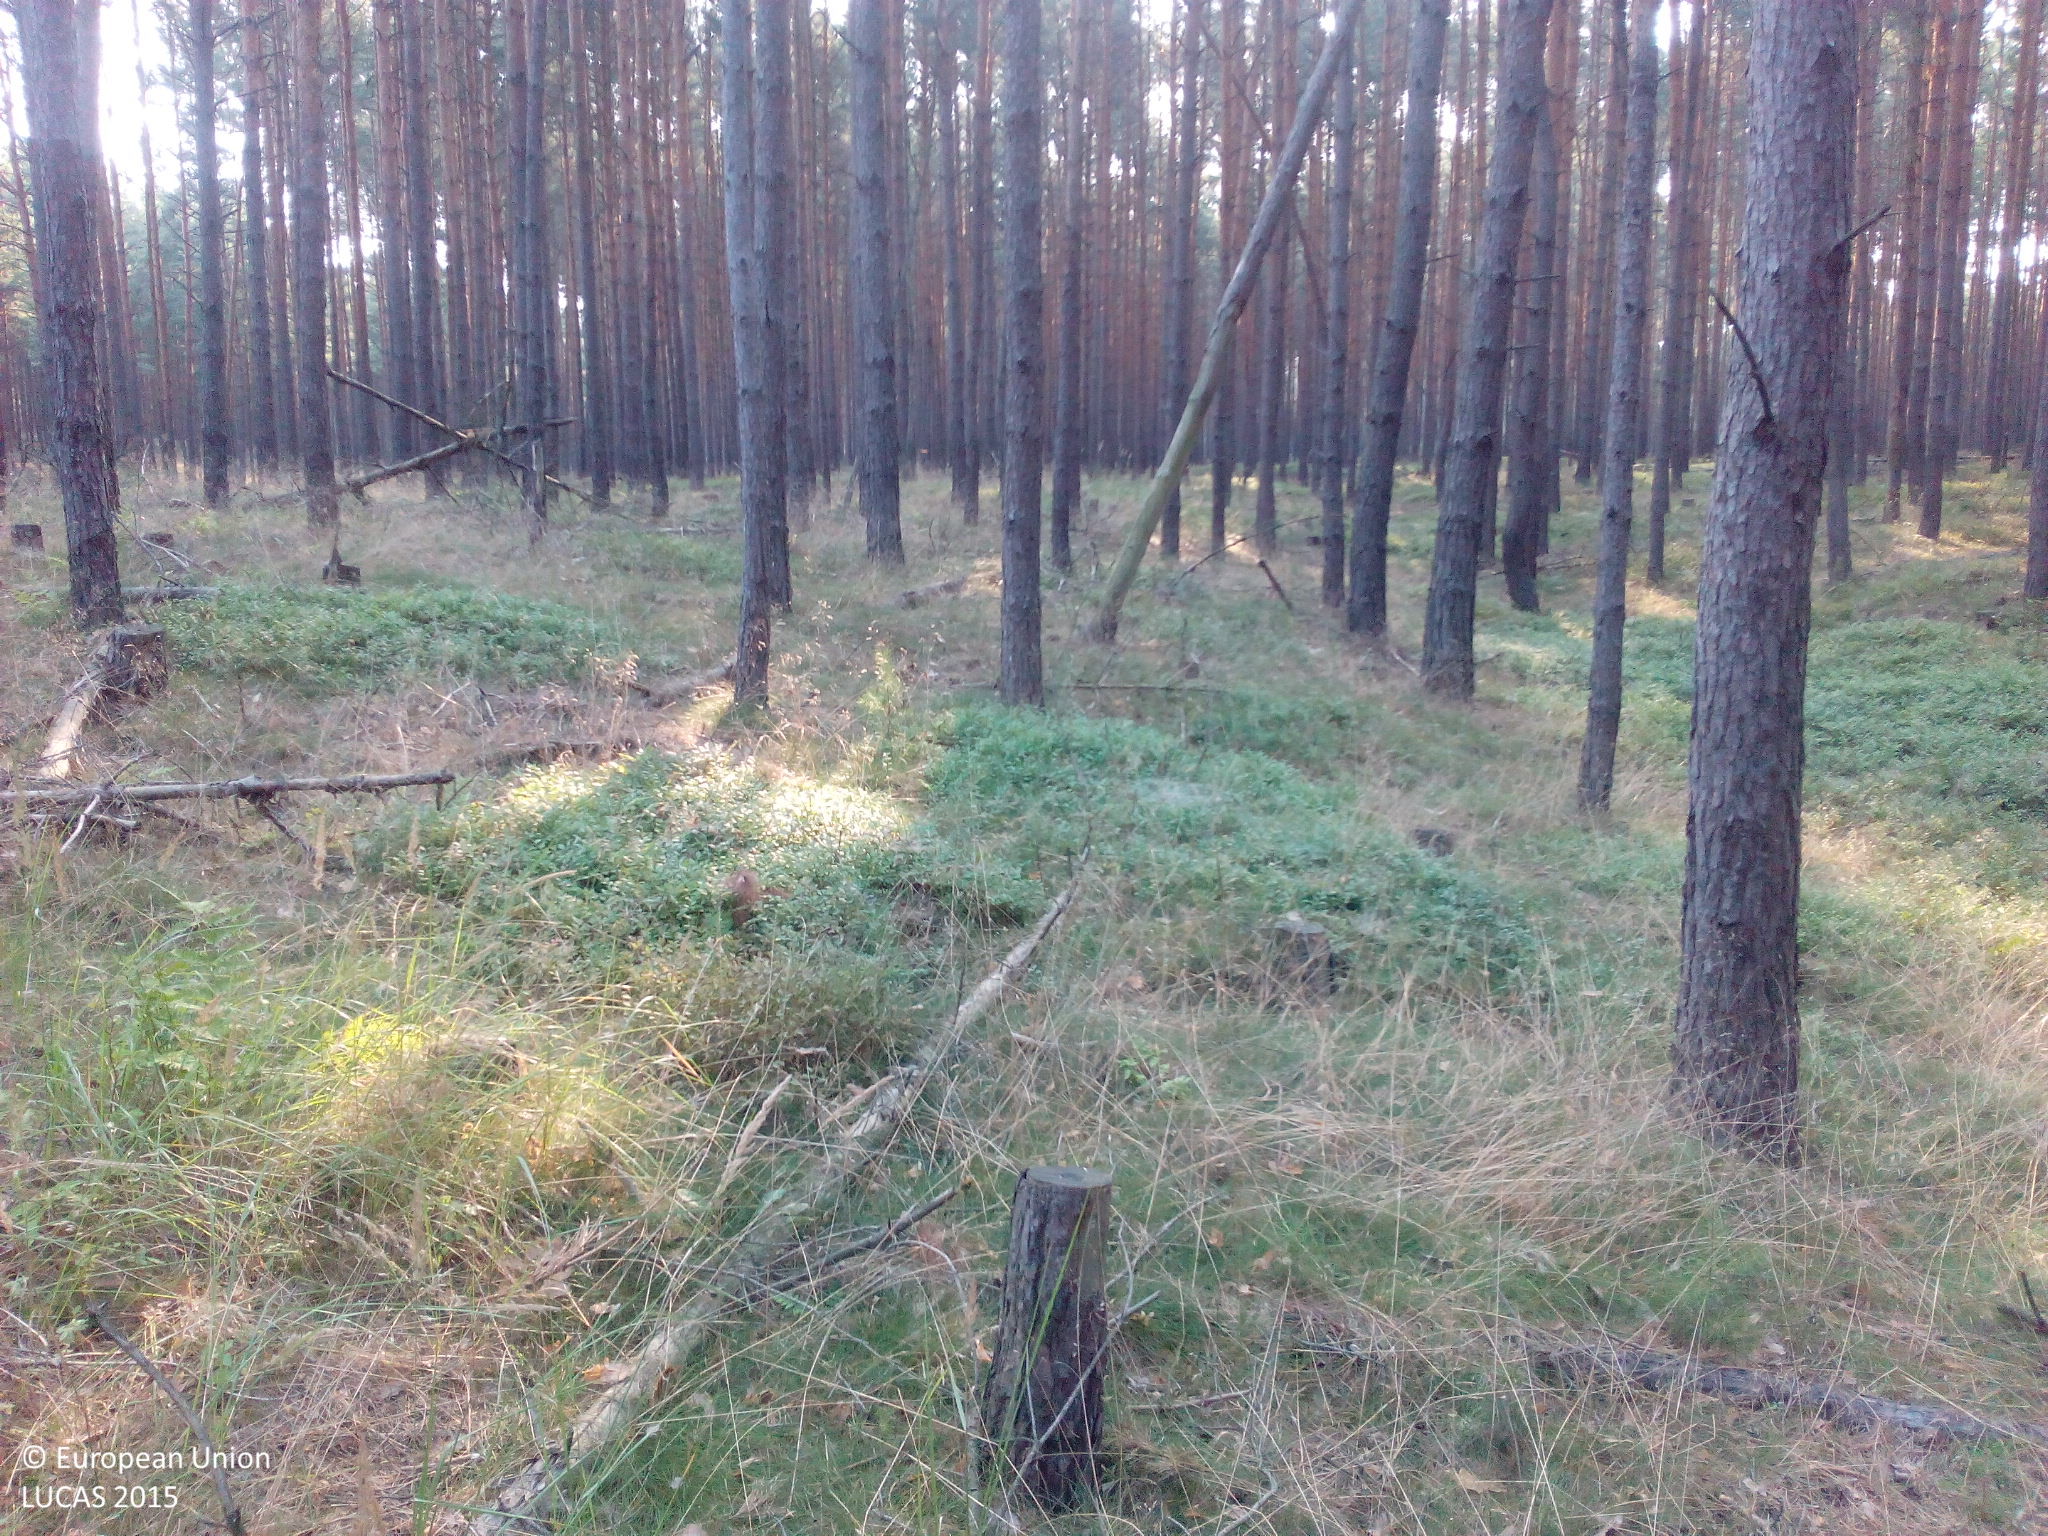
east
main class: Woodland
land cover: Pine dominated coniferous woodland
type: hemiboreal forest and nemoral coniferous forest and mixed broadleaved-coniferous forest
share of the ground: > 75 %
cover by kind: coniferous forest trees 95 %, herbaceous plants 5 %
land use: Forestry
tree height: > 5 m
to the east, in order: Pine dominated coniferous woodland
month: August
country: DE
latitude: 51.6795
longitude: 13.4569
